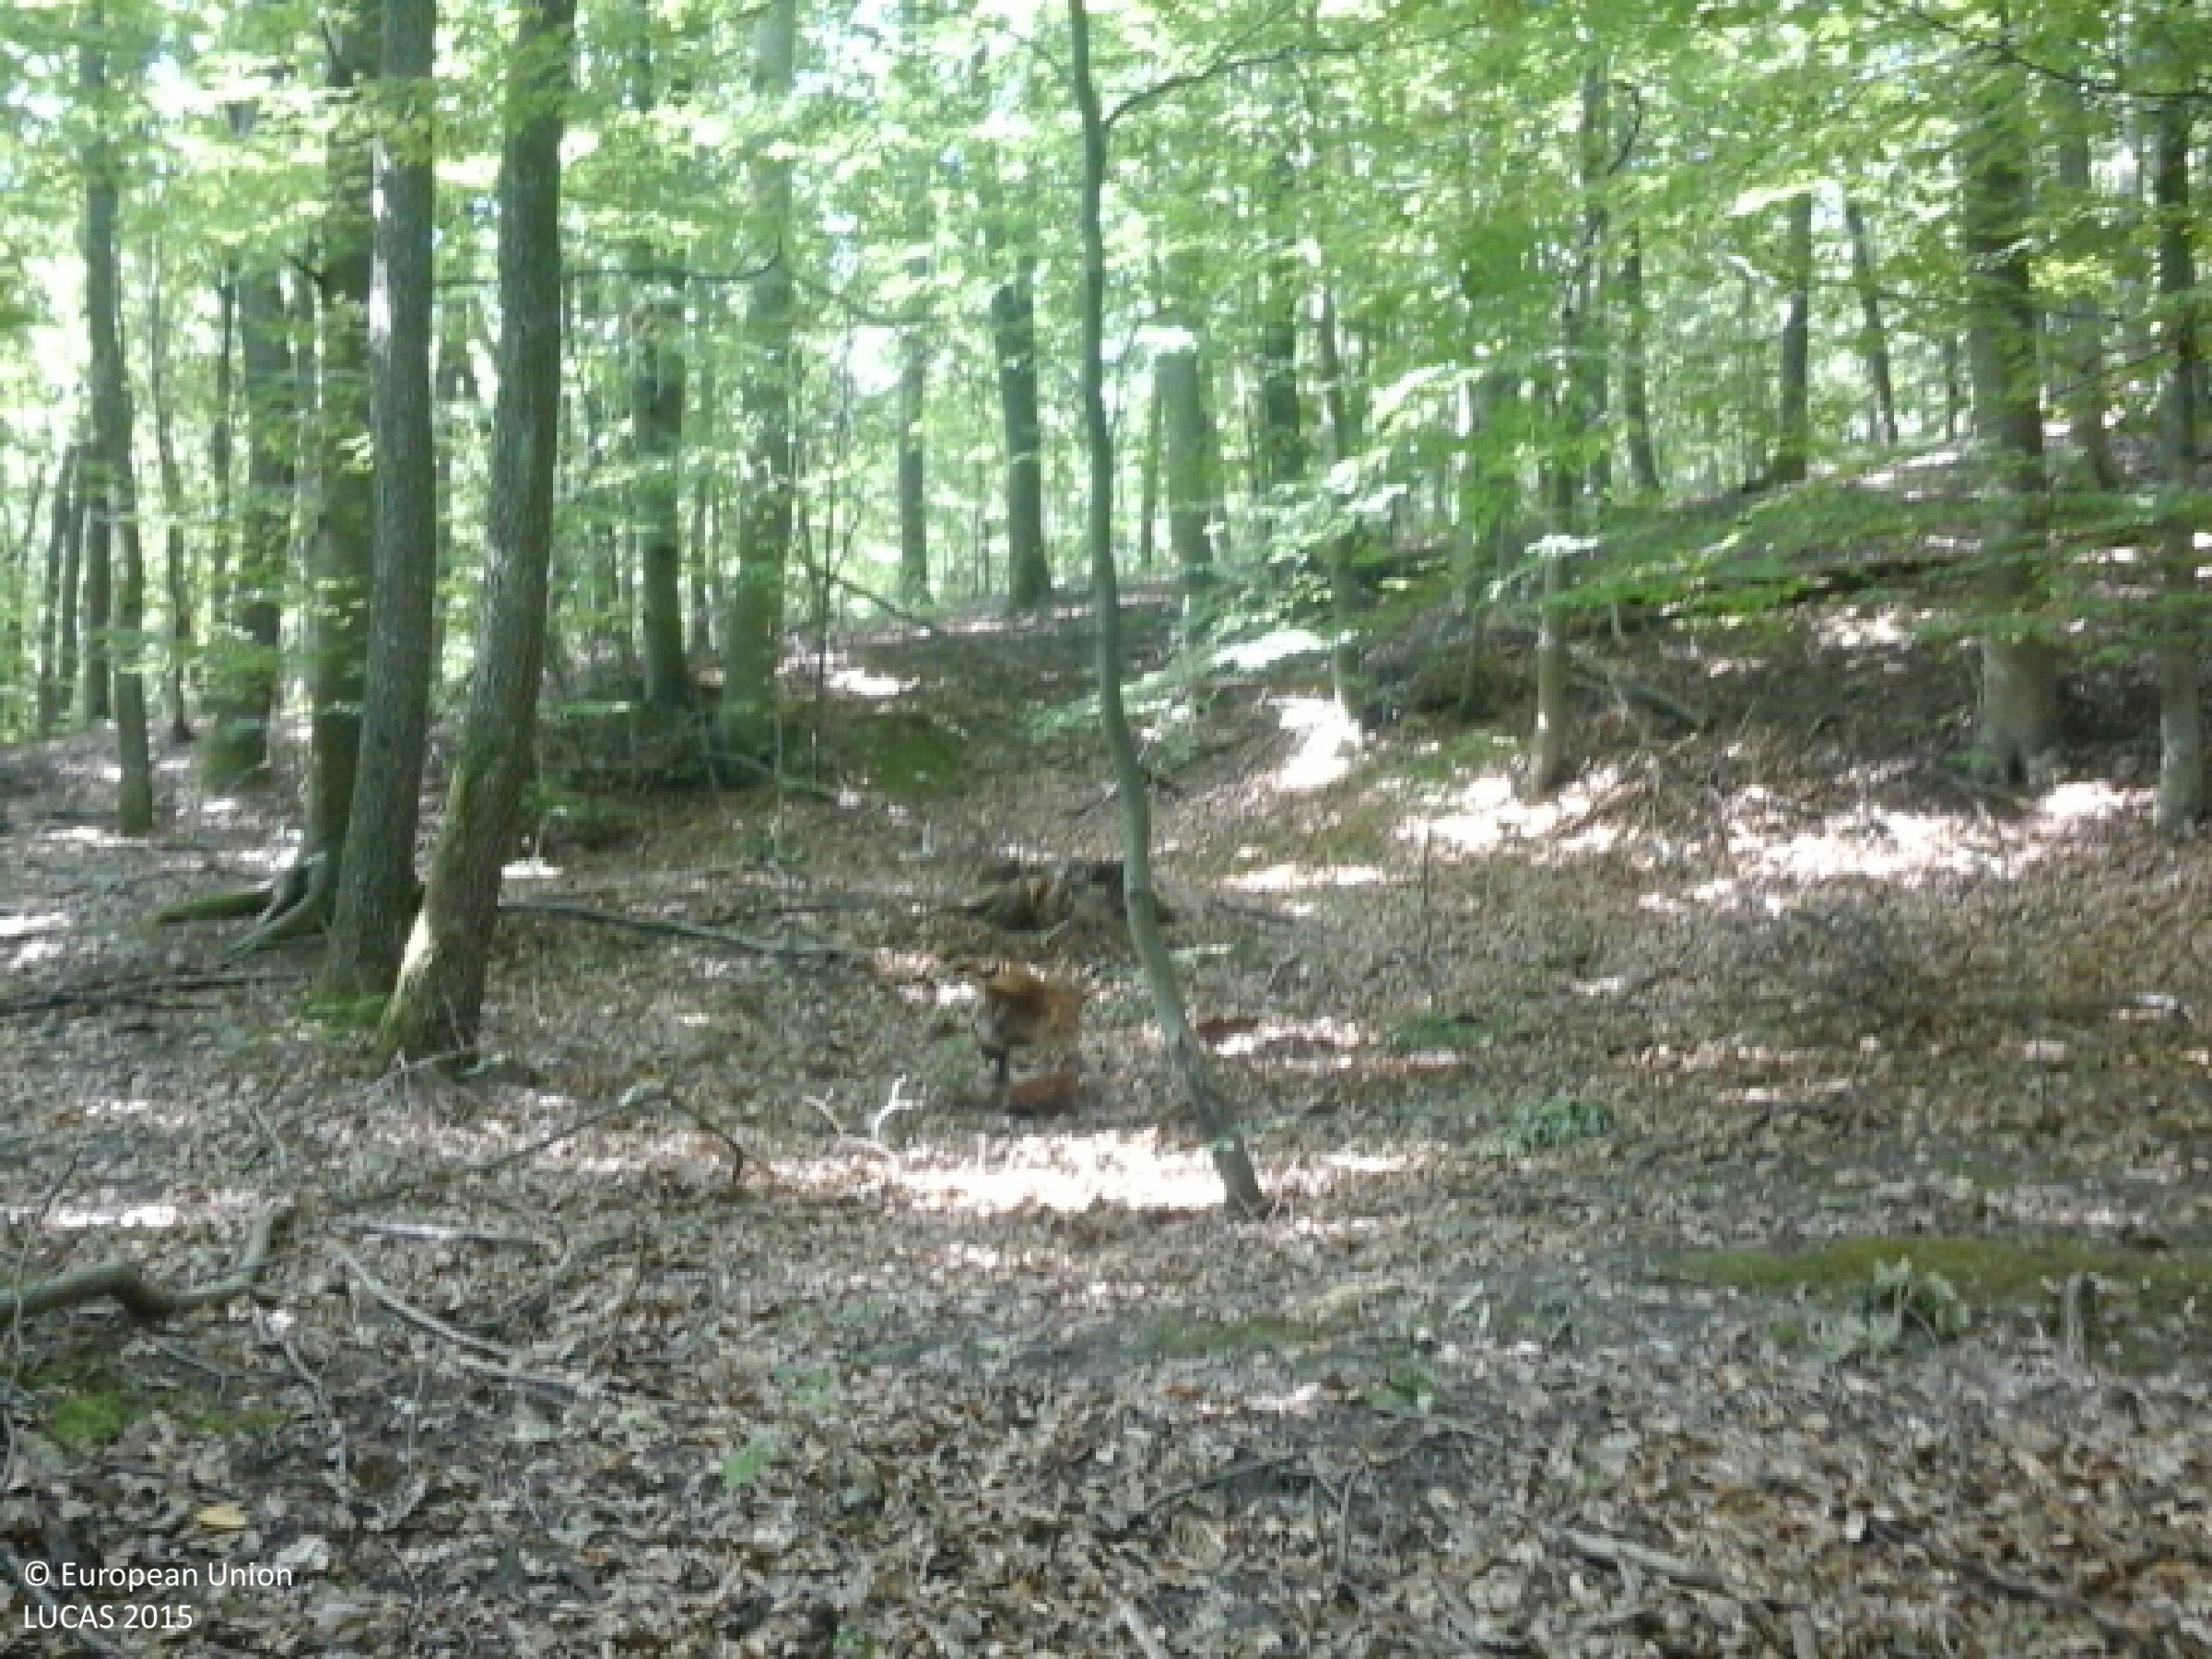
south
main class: Woodland
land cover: Broadleaved woodland
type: mesophytic deciduous forest
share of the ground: > 75 %
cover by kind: broadleaved forest trees 100 %
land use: Forestry
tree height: > 5 m
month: July
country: HU
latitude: 48.3789
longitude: 21.5370
